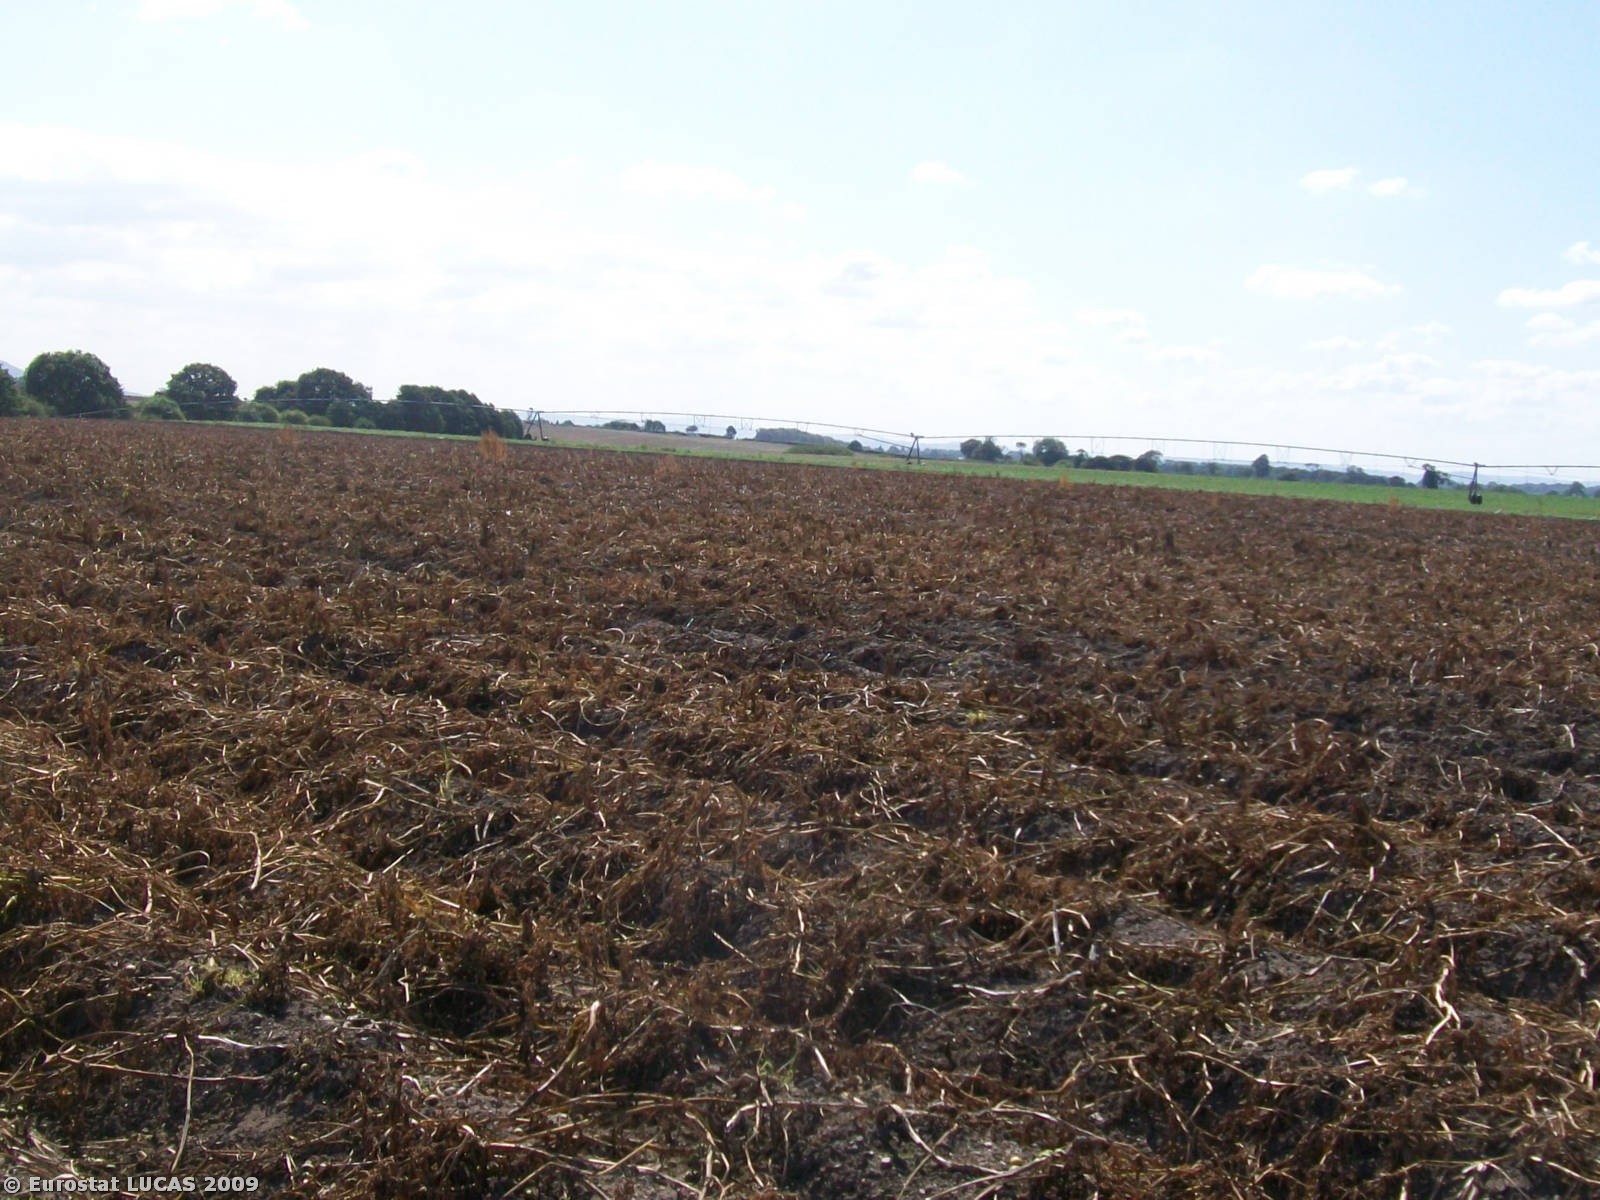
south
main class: Cropland
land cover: Potatoes
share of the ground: > 75 %
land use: Agriculture (excluding fallow land and kitchen gardens)
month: September
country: GB
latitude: 52.7744
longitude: -2.6236
